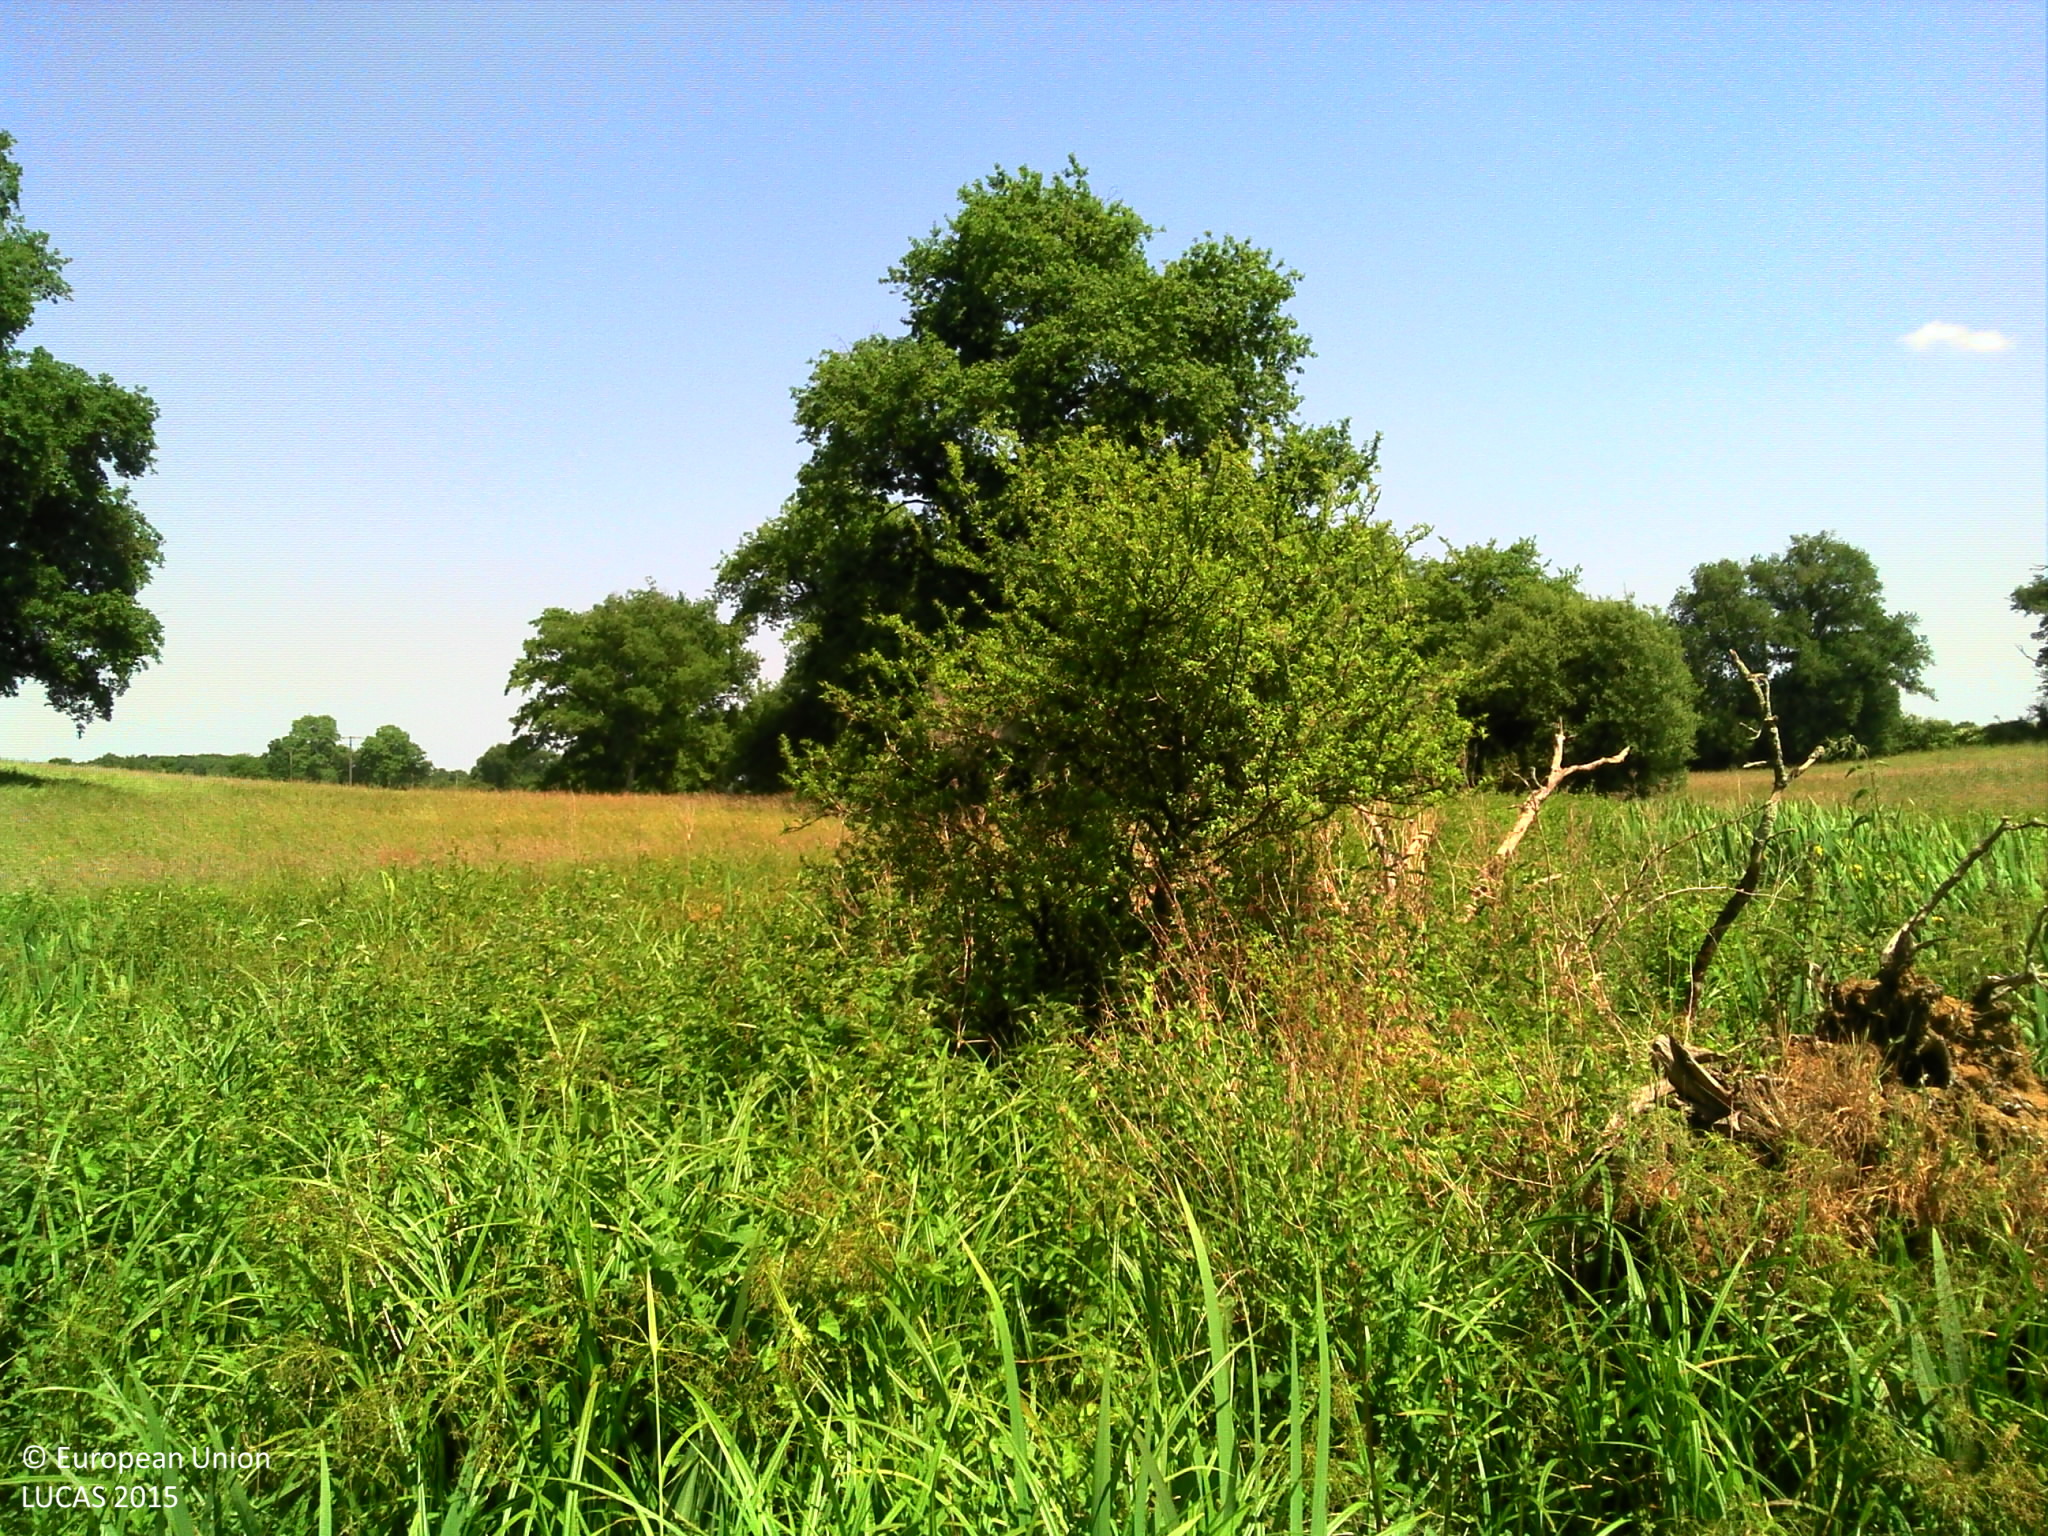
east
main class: Grassland
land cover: Spontaneously vegetated surfaces
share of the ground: > 75 %
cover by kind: herbaceous plants 95 %, shrubs 5 %
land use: Agriculture (excluding fallow land and kitchen gardens)
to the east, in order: Spontaneously vegetated surfaces; Grassland without tree/shrub cover; Rivers and streams; Grassland without tree/shrub cover; Managed hedges; Grassland without tree/shrub cover; Rivers and streams; Grassland without tree/shrub cover
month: June
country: FR
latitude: 46.0577
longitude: 0.5359
